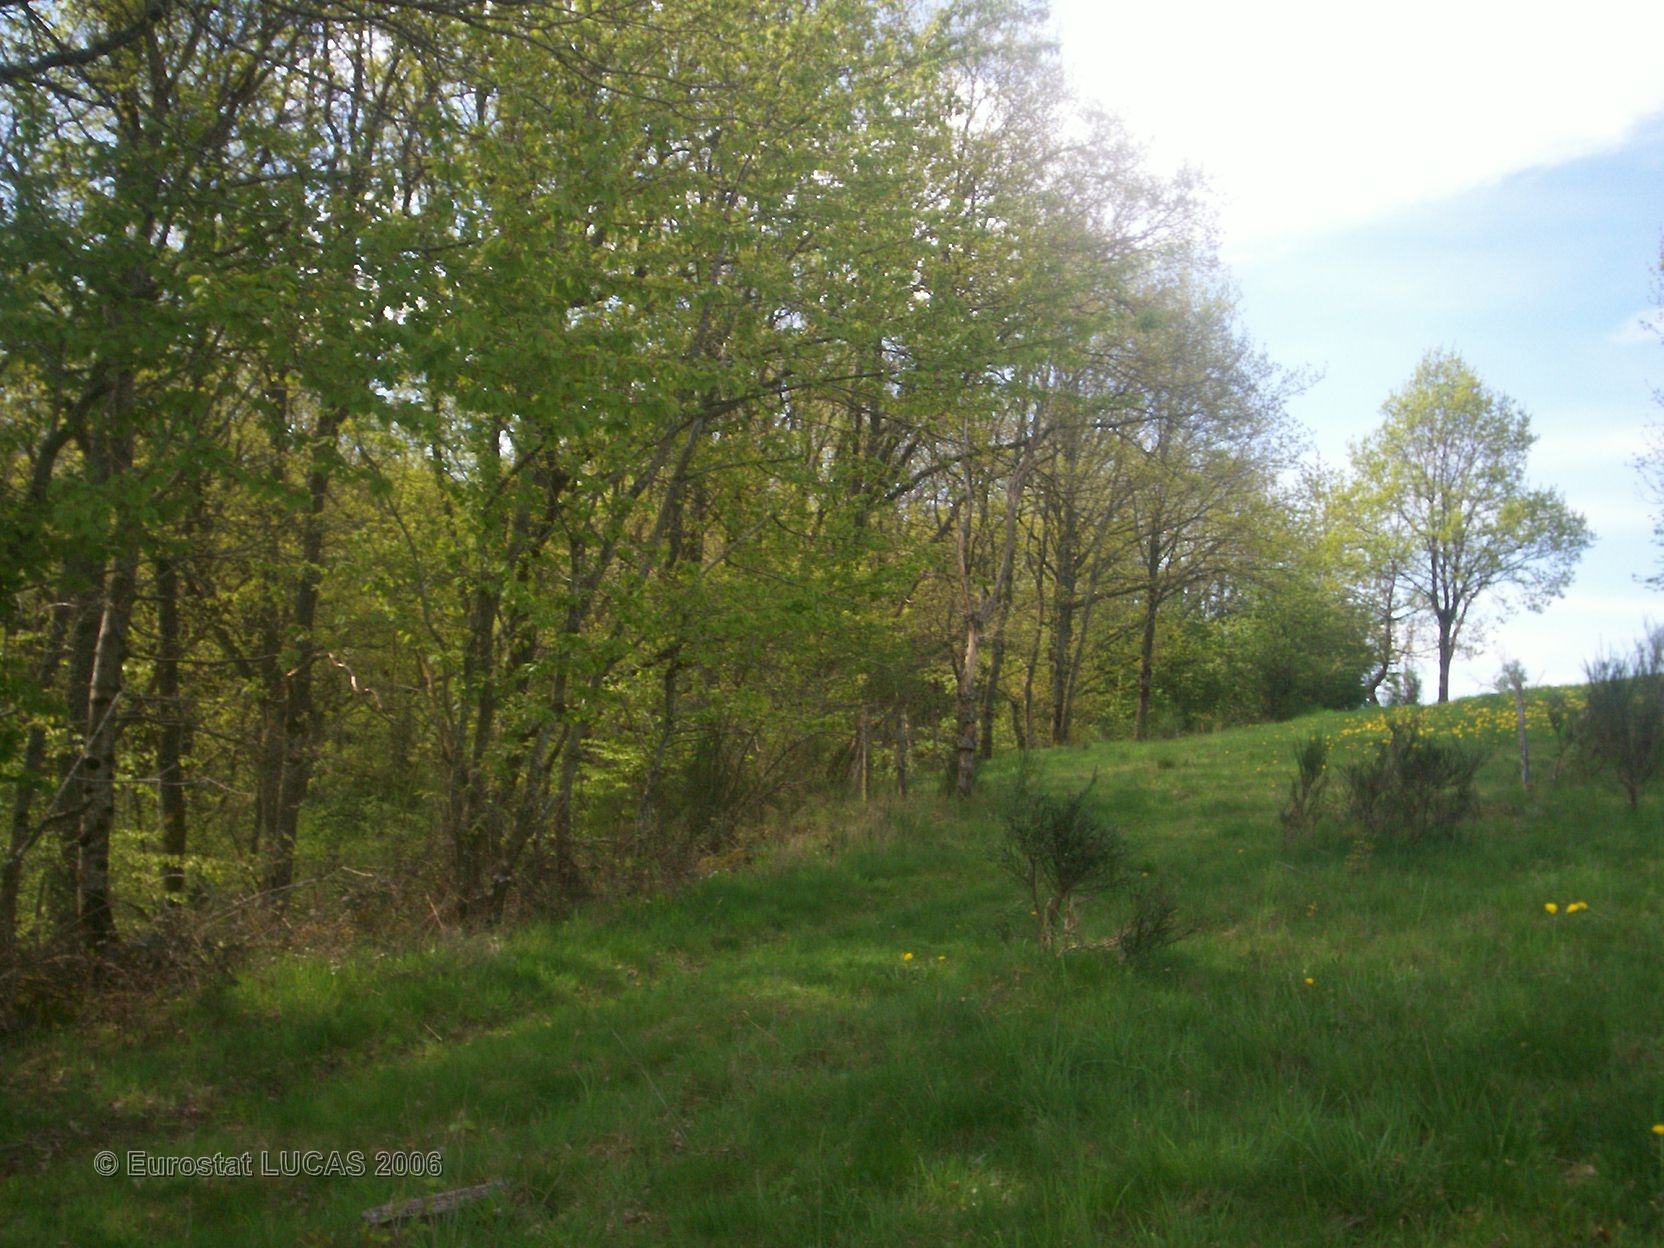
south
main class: Grassland
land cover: Grassland without tree/shrub cover
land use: Agriculture (excluding fallow land and kitchen gardens)
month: May
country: FR
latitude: 45.9714
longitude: 2.9132
